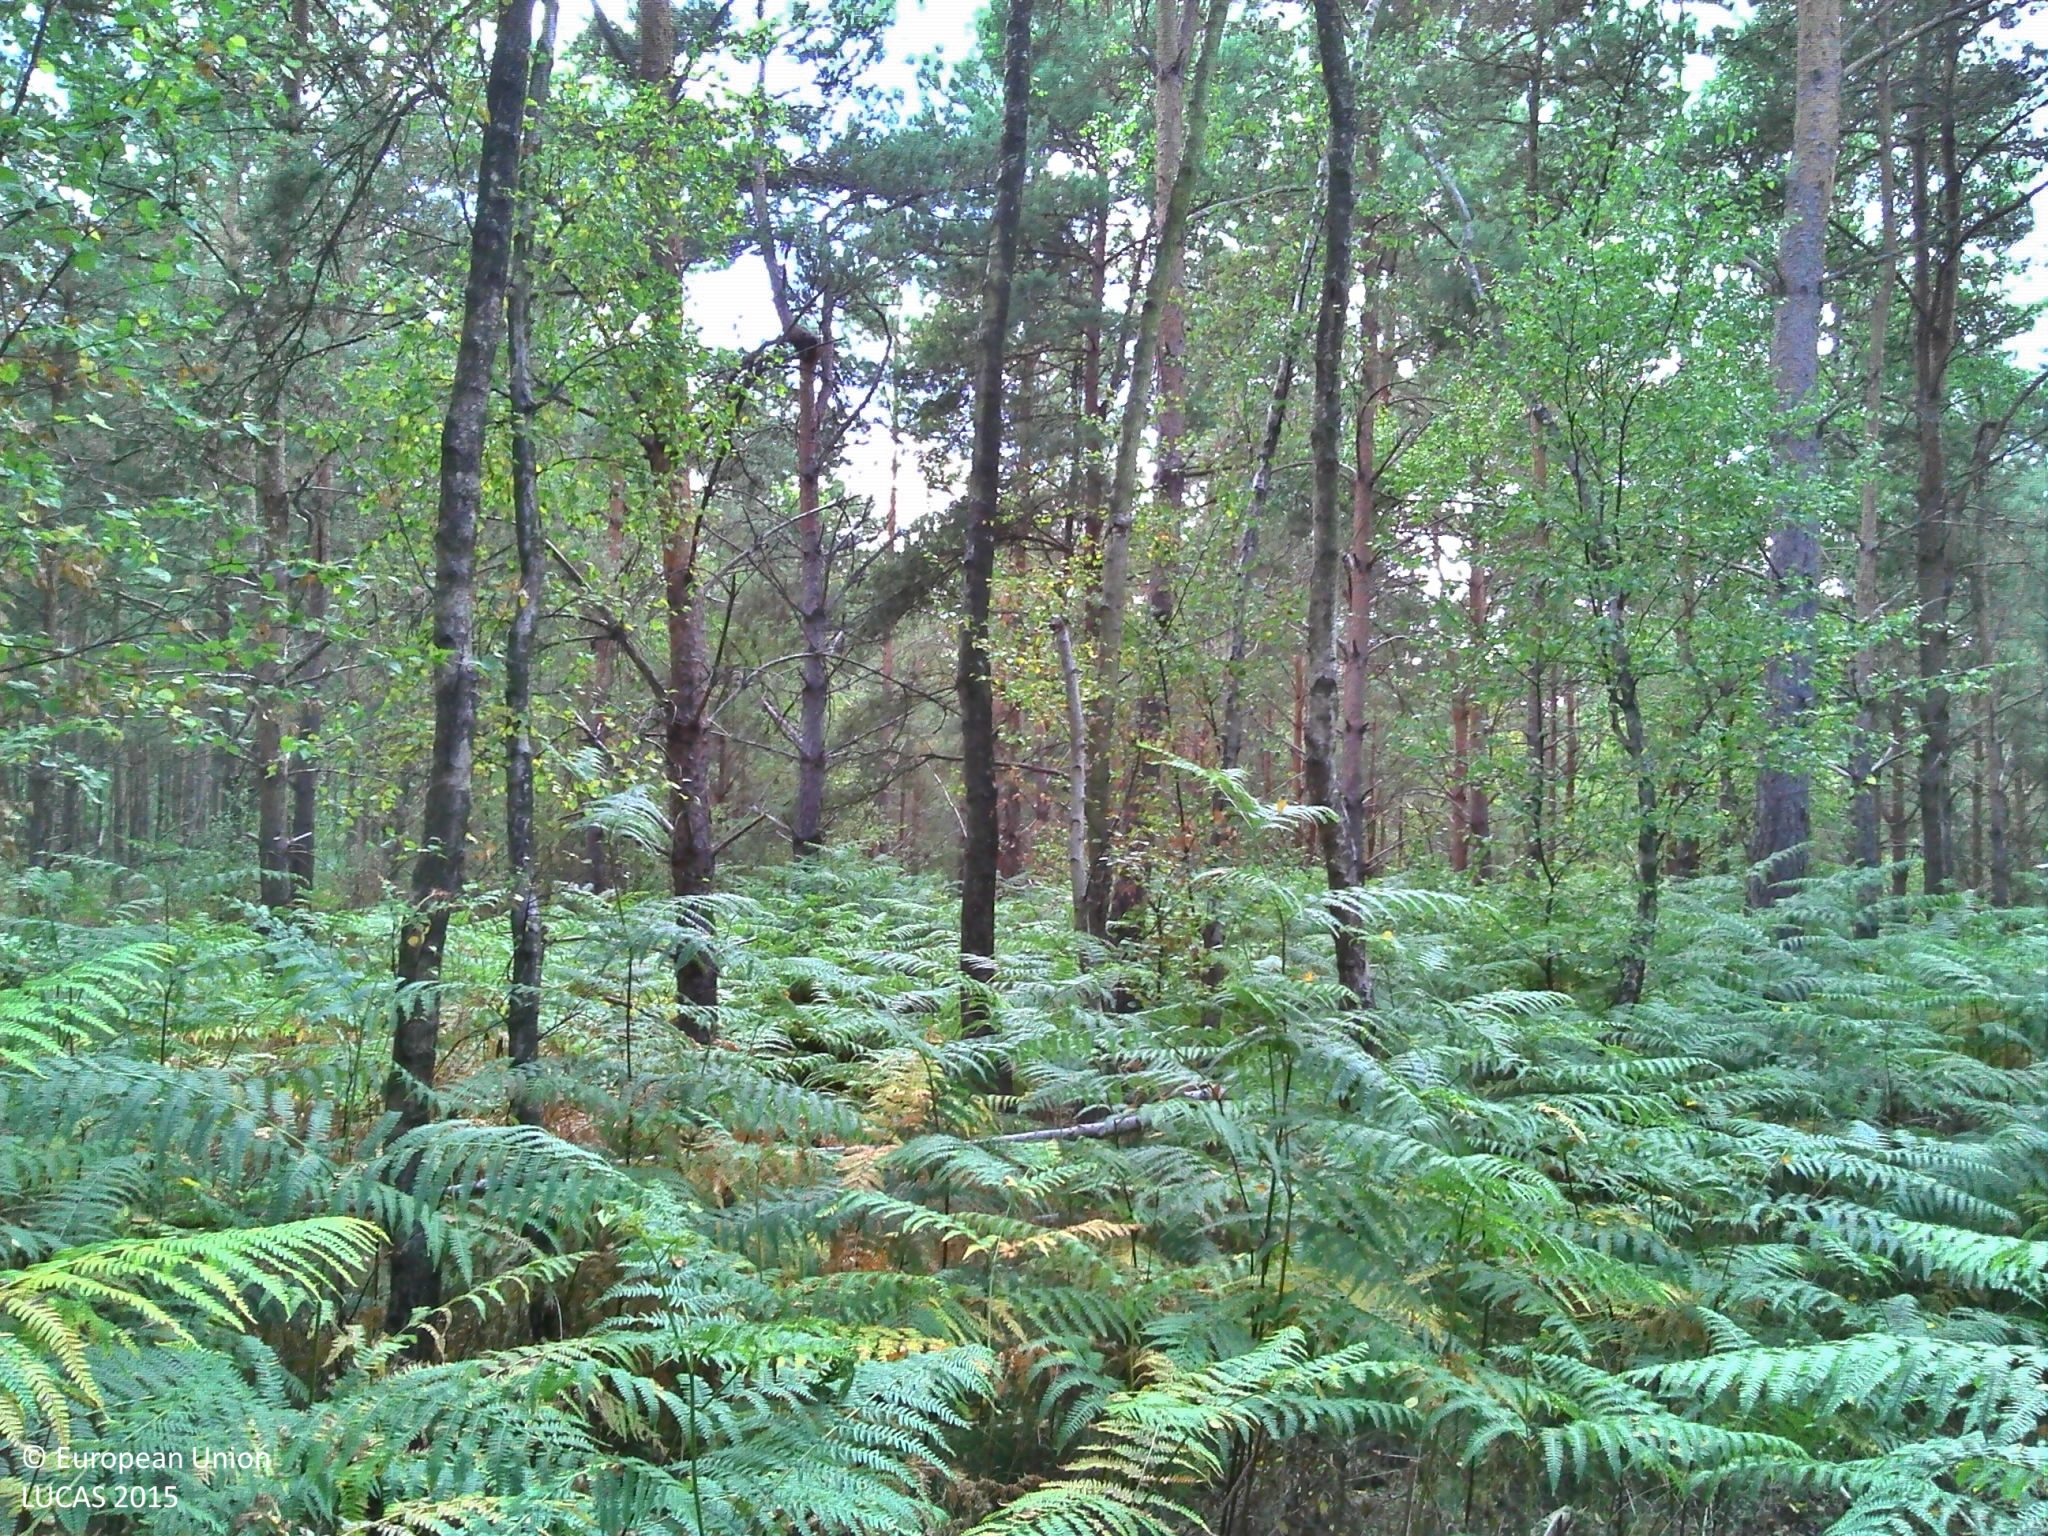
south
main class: Woodland
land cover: Pine dominated mixed woodland
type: non-riverine alder, birch or aspen forest
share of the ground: > 75 %
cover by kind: coniferous forest trees 50 %, broadleaved forest trees 20 %, shrubs 20 %, herbaceous plants 10 %
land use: Forestry
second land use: Amenities, museums, leisure
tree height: > 5 m
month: July
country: FR
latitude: 49.1507
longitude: 2.6266
